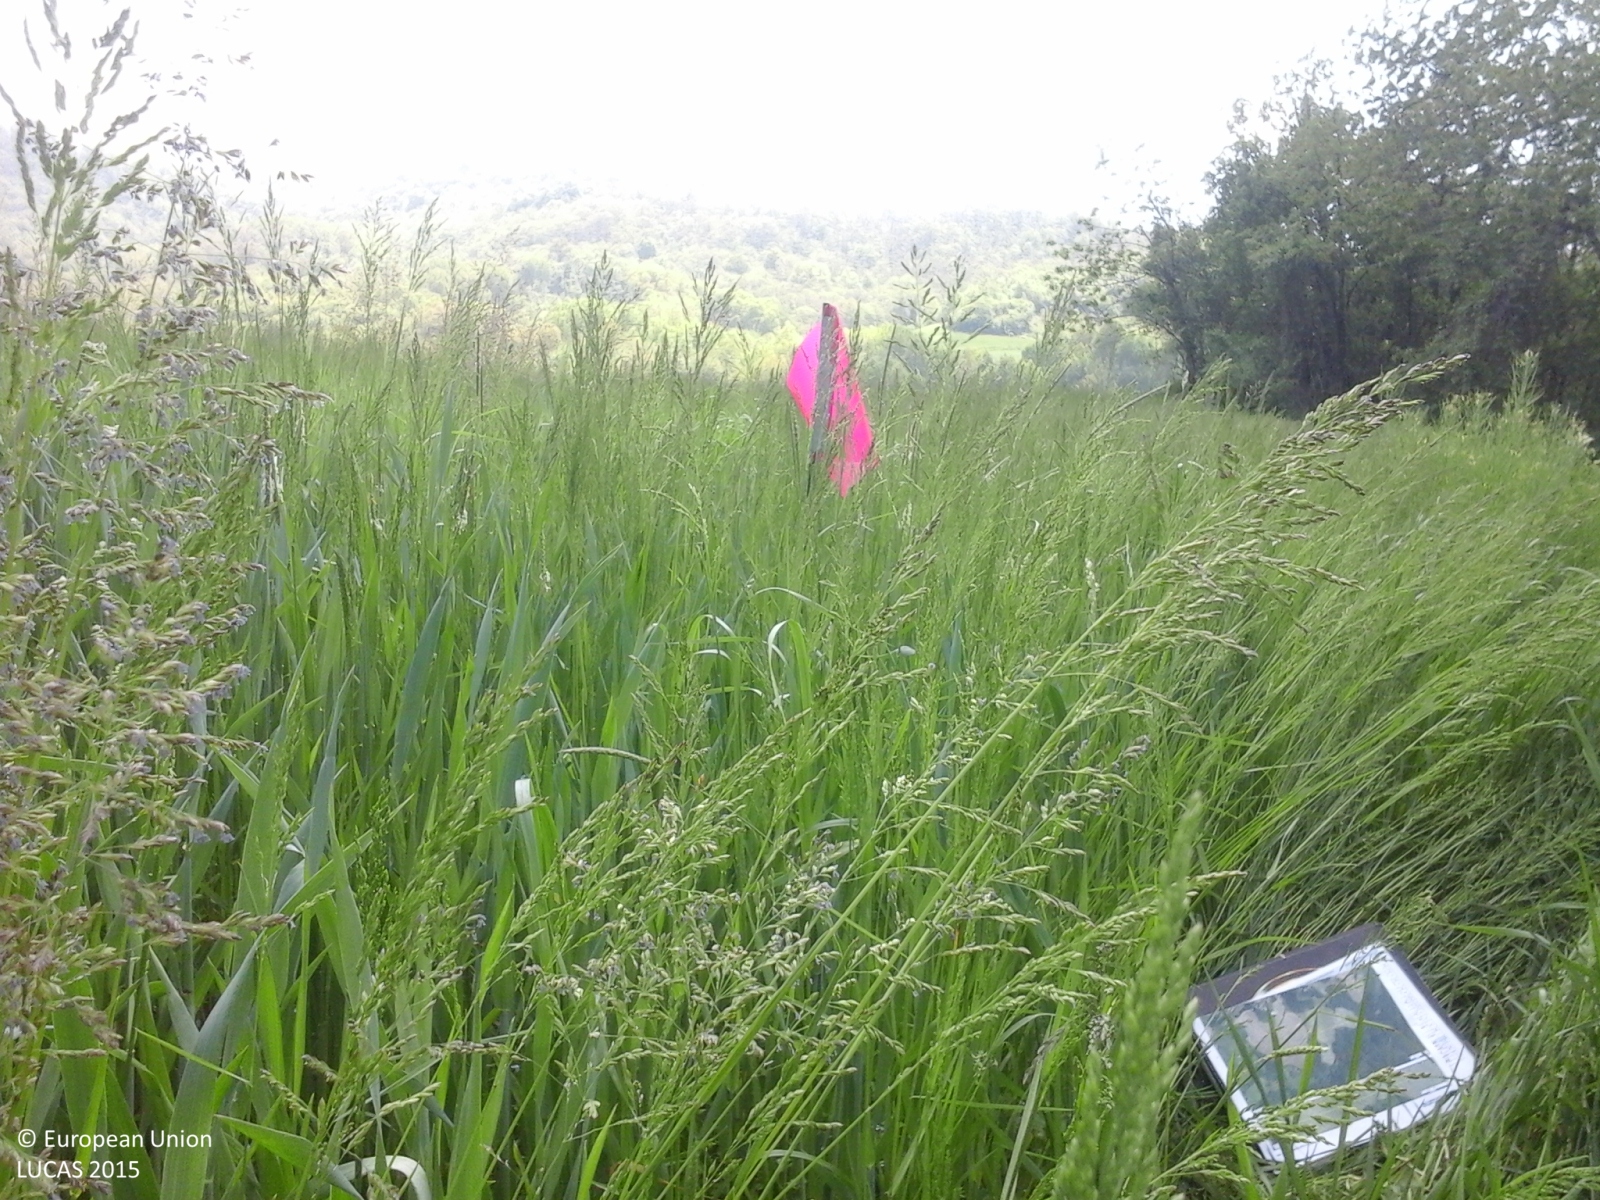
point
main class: Cropland
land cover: Common wheat
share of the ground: > 75 %
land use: Agriculture (excluding fallow land and kitchen gardens)
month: May
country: IT
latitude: 44.3278
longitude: 10.9884
